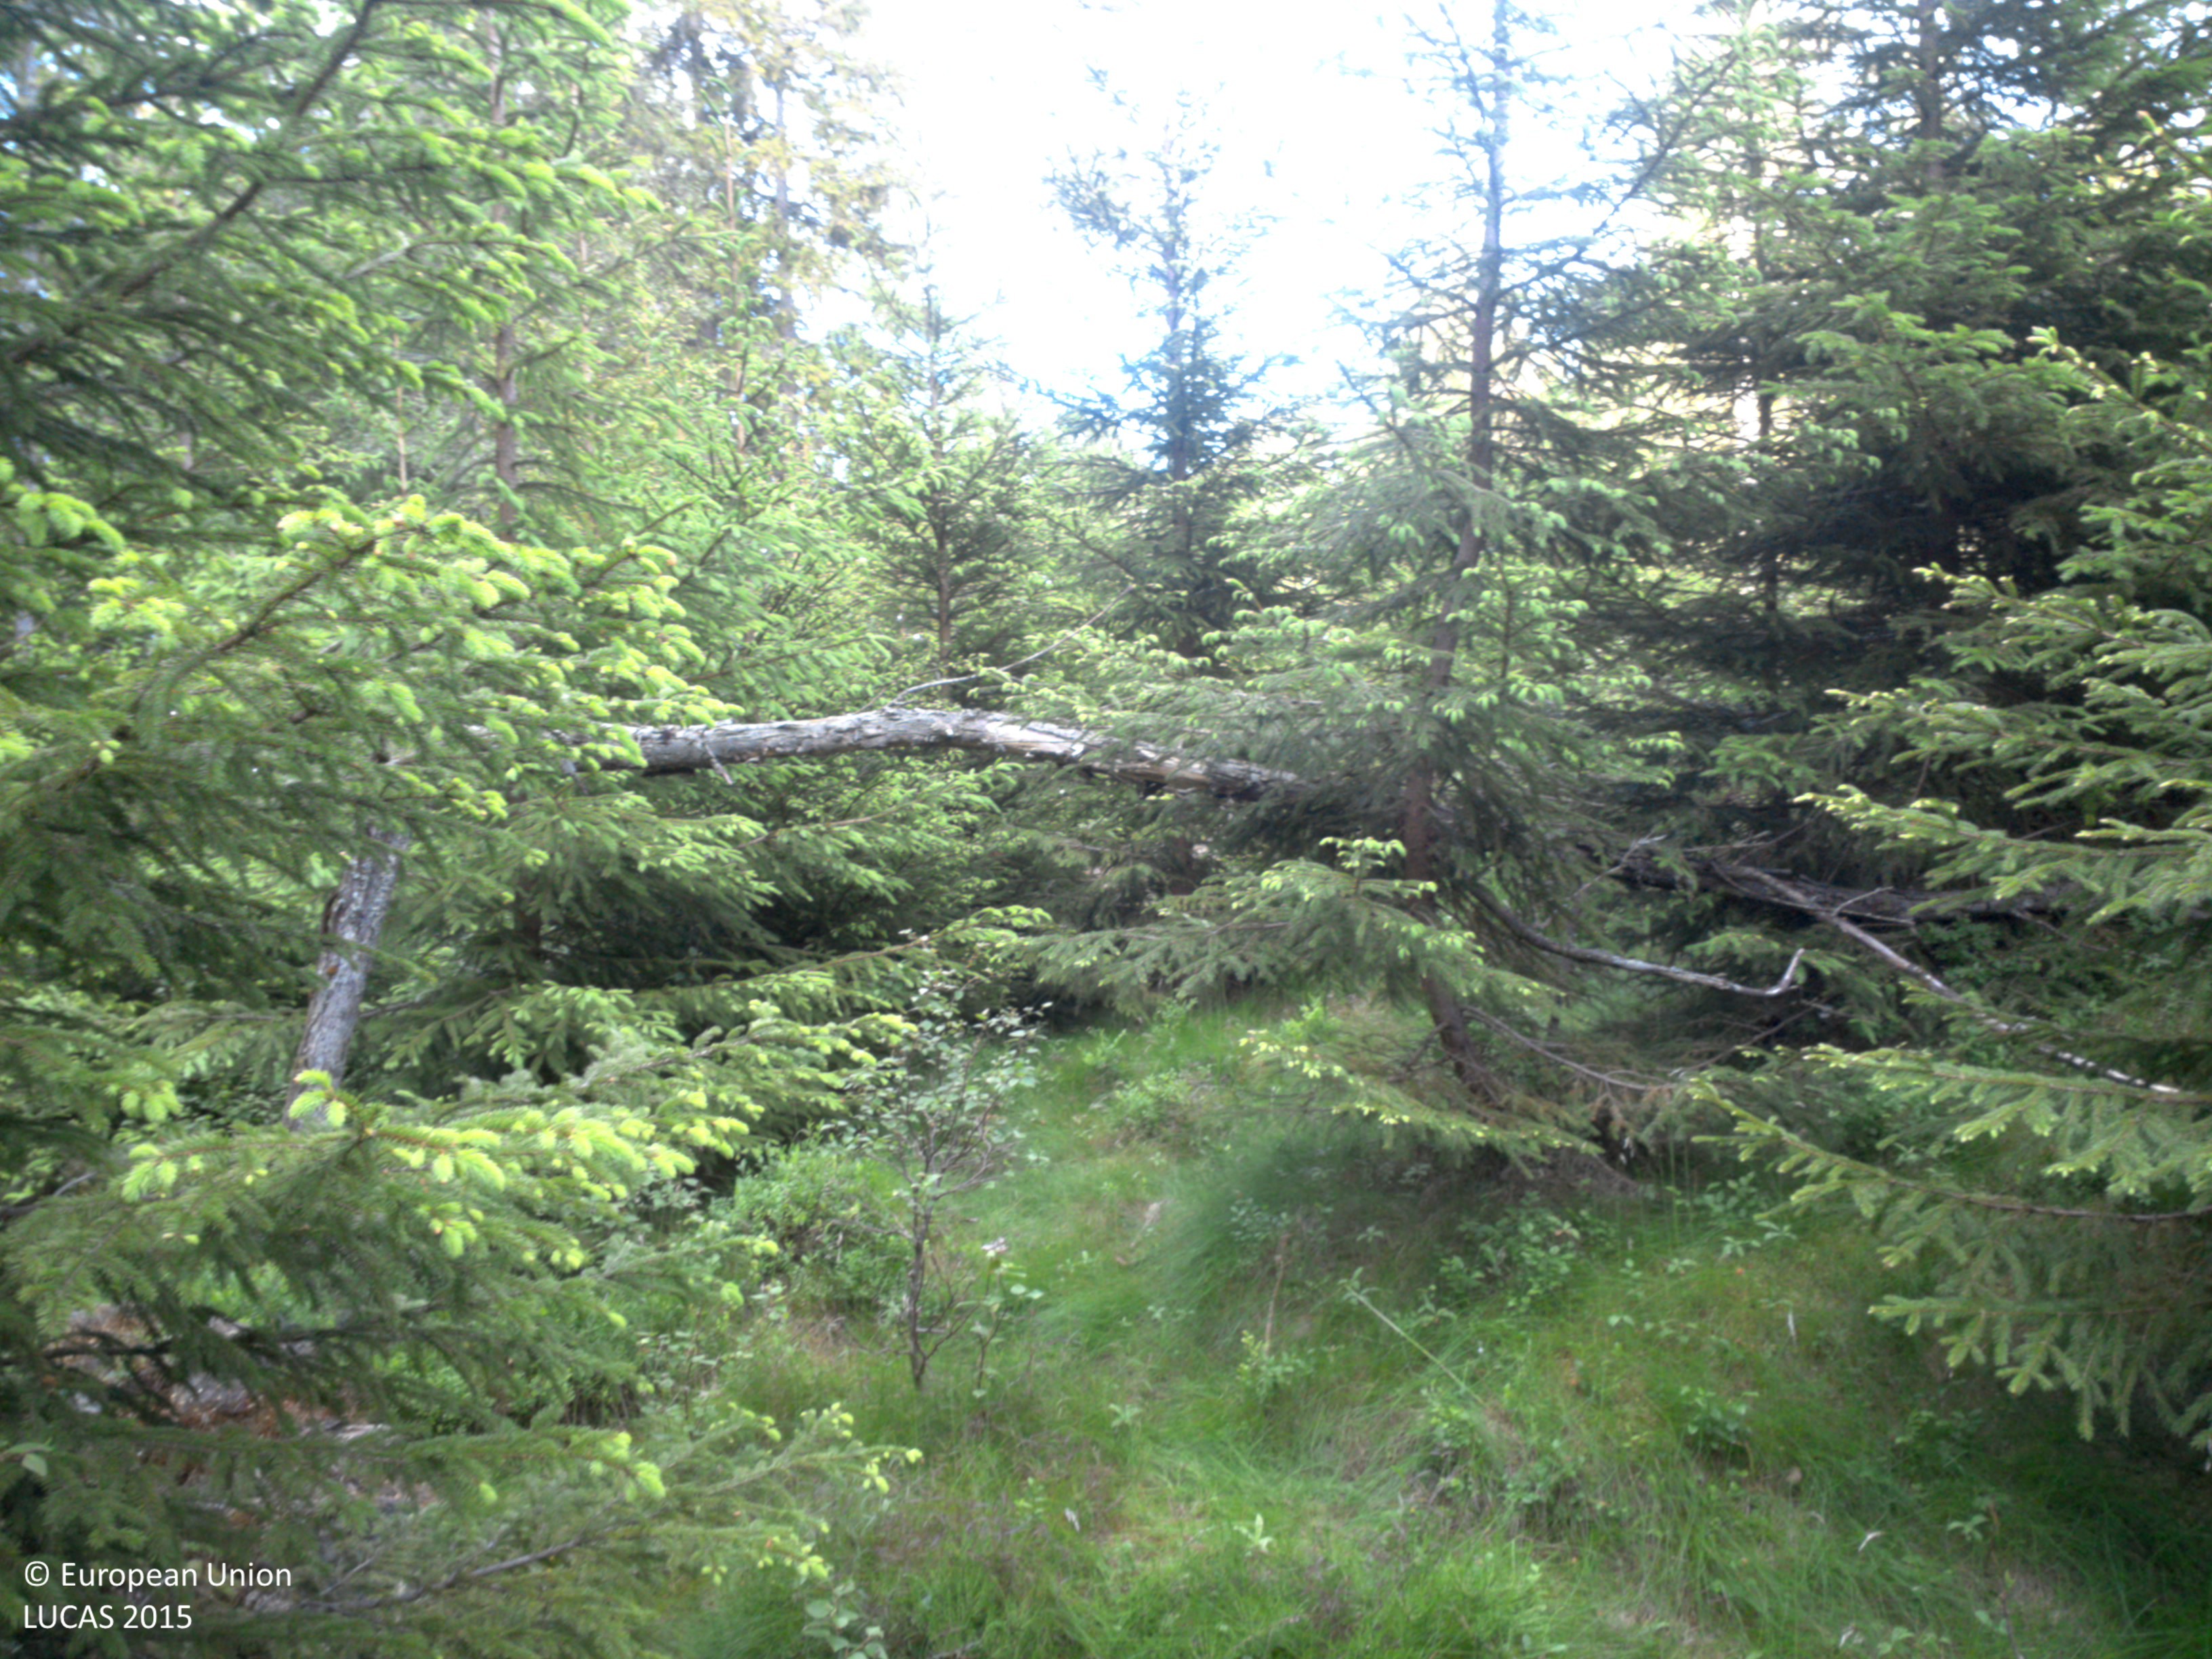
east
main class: Woodland
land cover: Spruce dominated coniferous woodland
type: boreal forest
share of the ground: 50 - 75 %
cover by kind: coniferous forest trees 55 %, herbaceous plants 40 %, broadleaved forest trees 5 %
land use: Forestry
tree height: > 5 m
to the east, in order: Spruce dominated coniferous woodland; Pine dominated coniferous woodland; Paved roads, cycling and walking lanes; Spruce dominated coniferous woodland; Rivers and streams; Spruce dominated coniferous woodland; Spruce dominated mixed woodland; Tracks; Spruce dominated mixed woodland
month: June
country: SE
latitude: 58.8662
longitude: 12.2665
